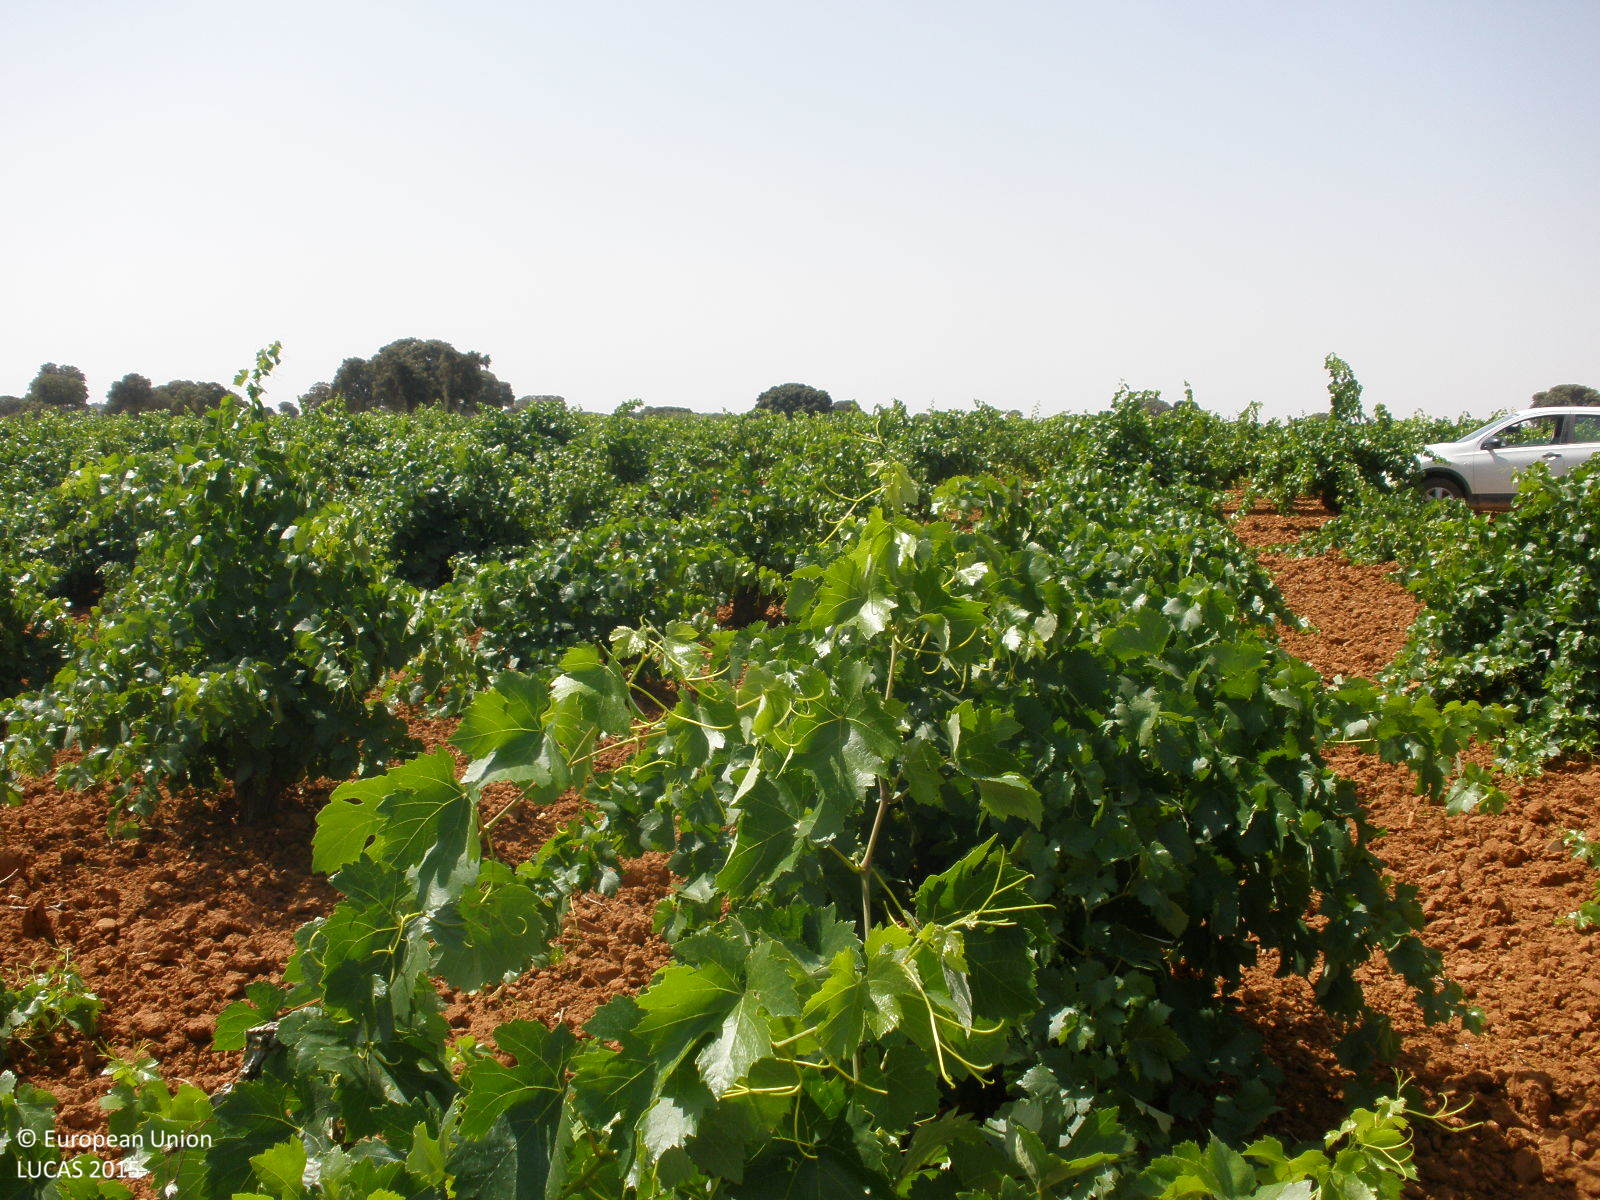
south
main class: Cropland
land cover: Vineyards
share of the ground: 50 - 75 %
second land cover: Other bare soil
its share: > 75 %
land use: Agriculture (excluding fallow land and kitchen gardens)
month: July
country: ES
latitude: 39.9106
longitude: -3.1375
